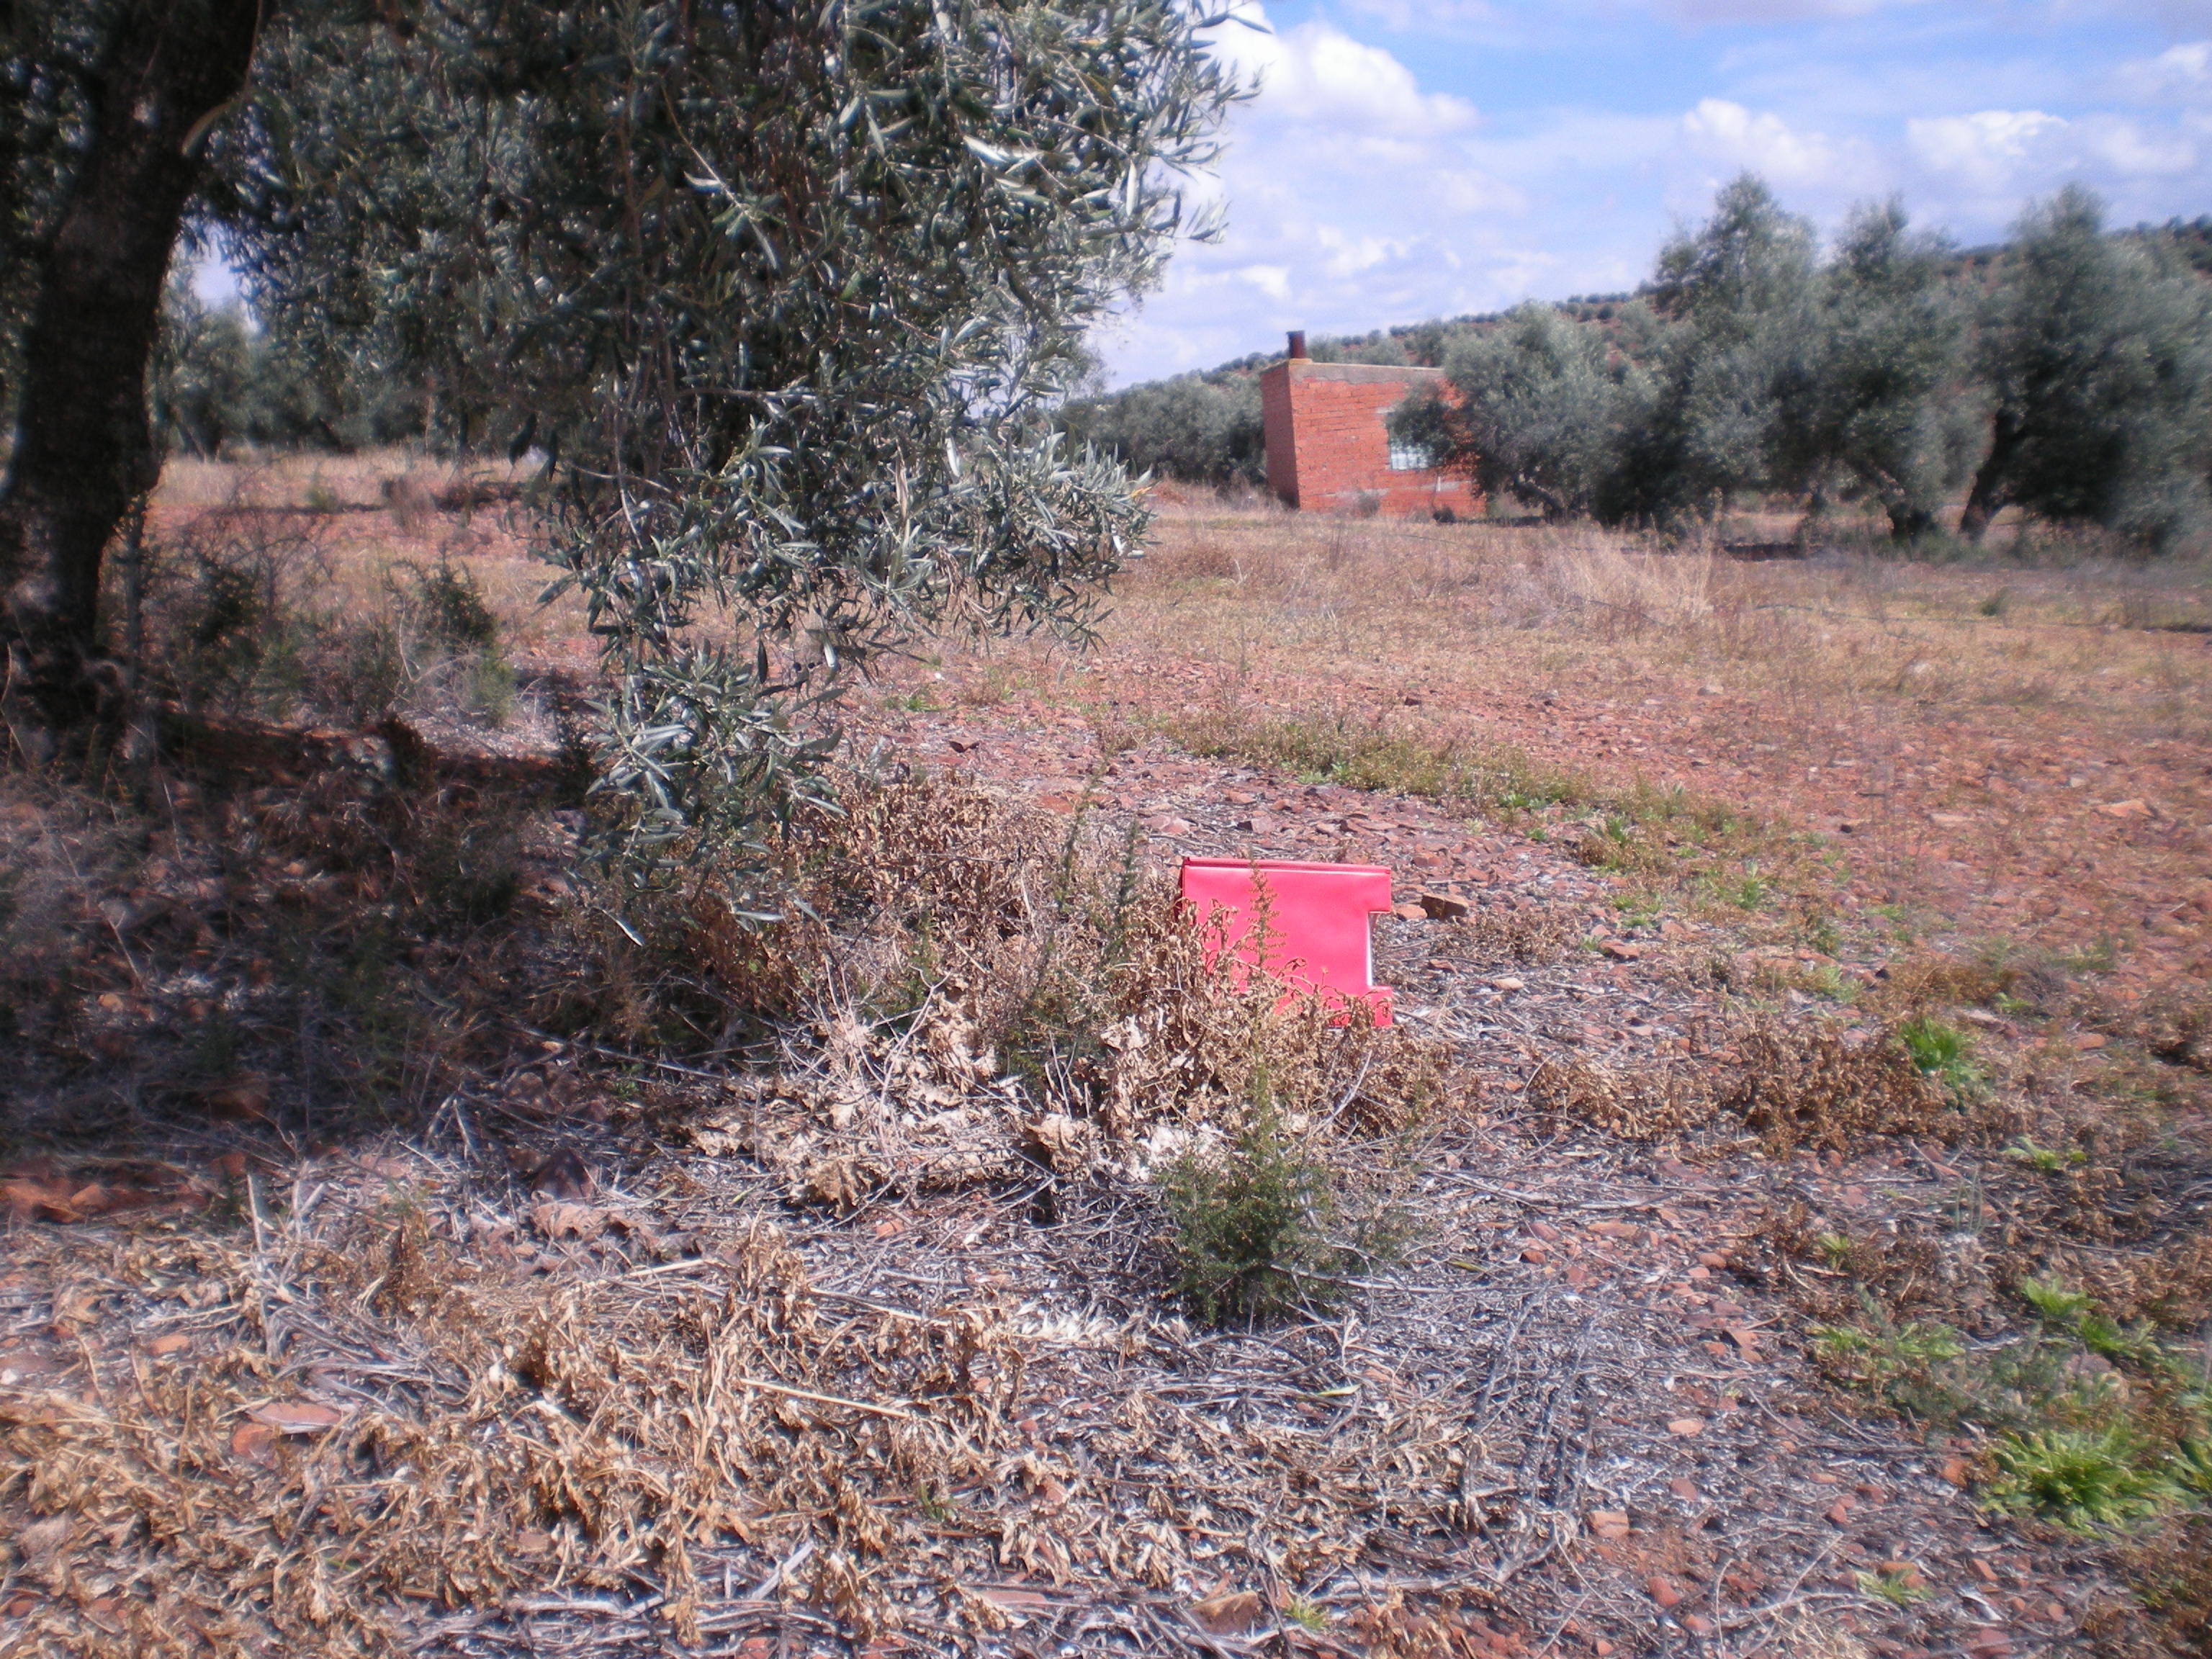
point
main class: Cropland
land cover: Olive groves
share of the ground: 25 - 50 %
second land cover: Other bare soil
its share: > 75 %
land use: Agriculture (excluding fallow land and kitchen gardens)
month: April
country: ES
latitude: 38.7567
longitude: -3.5337
